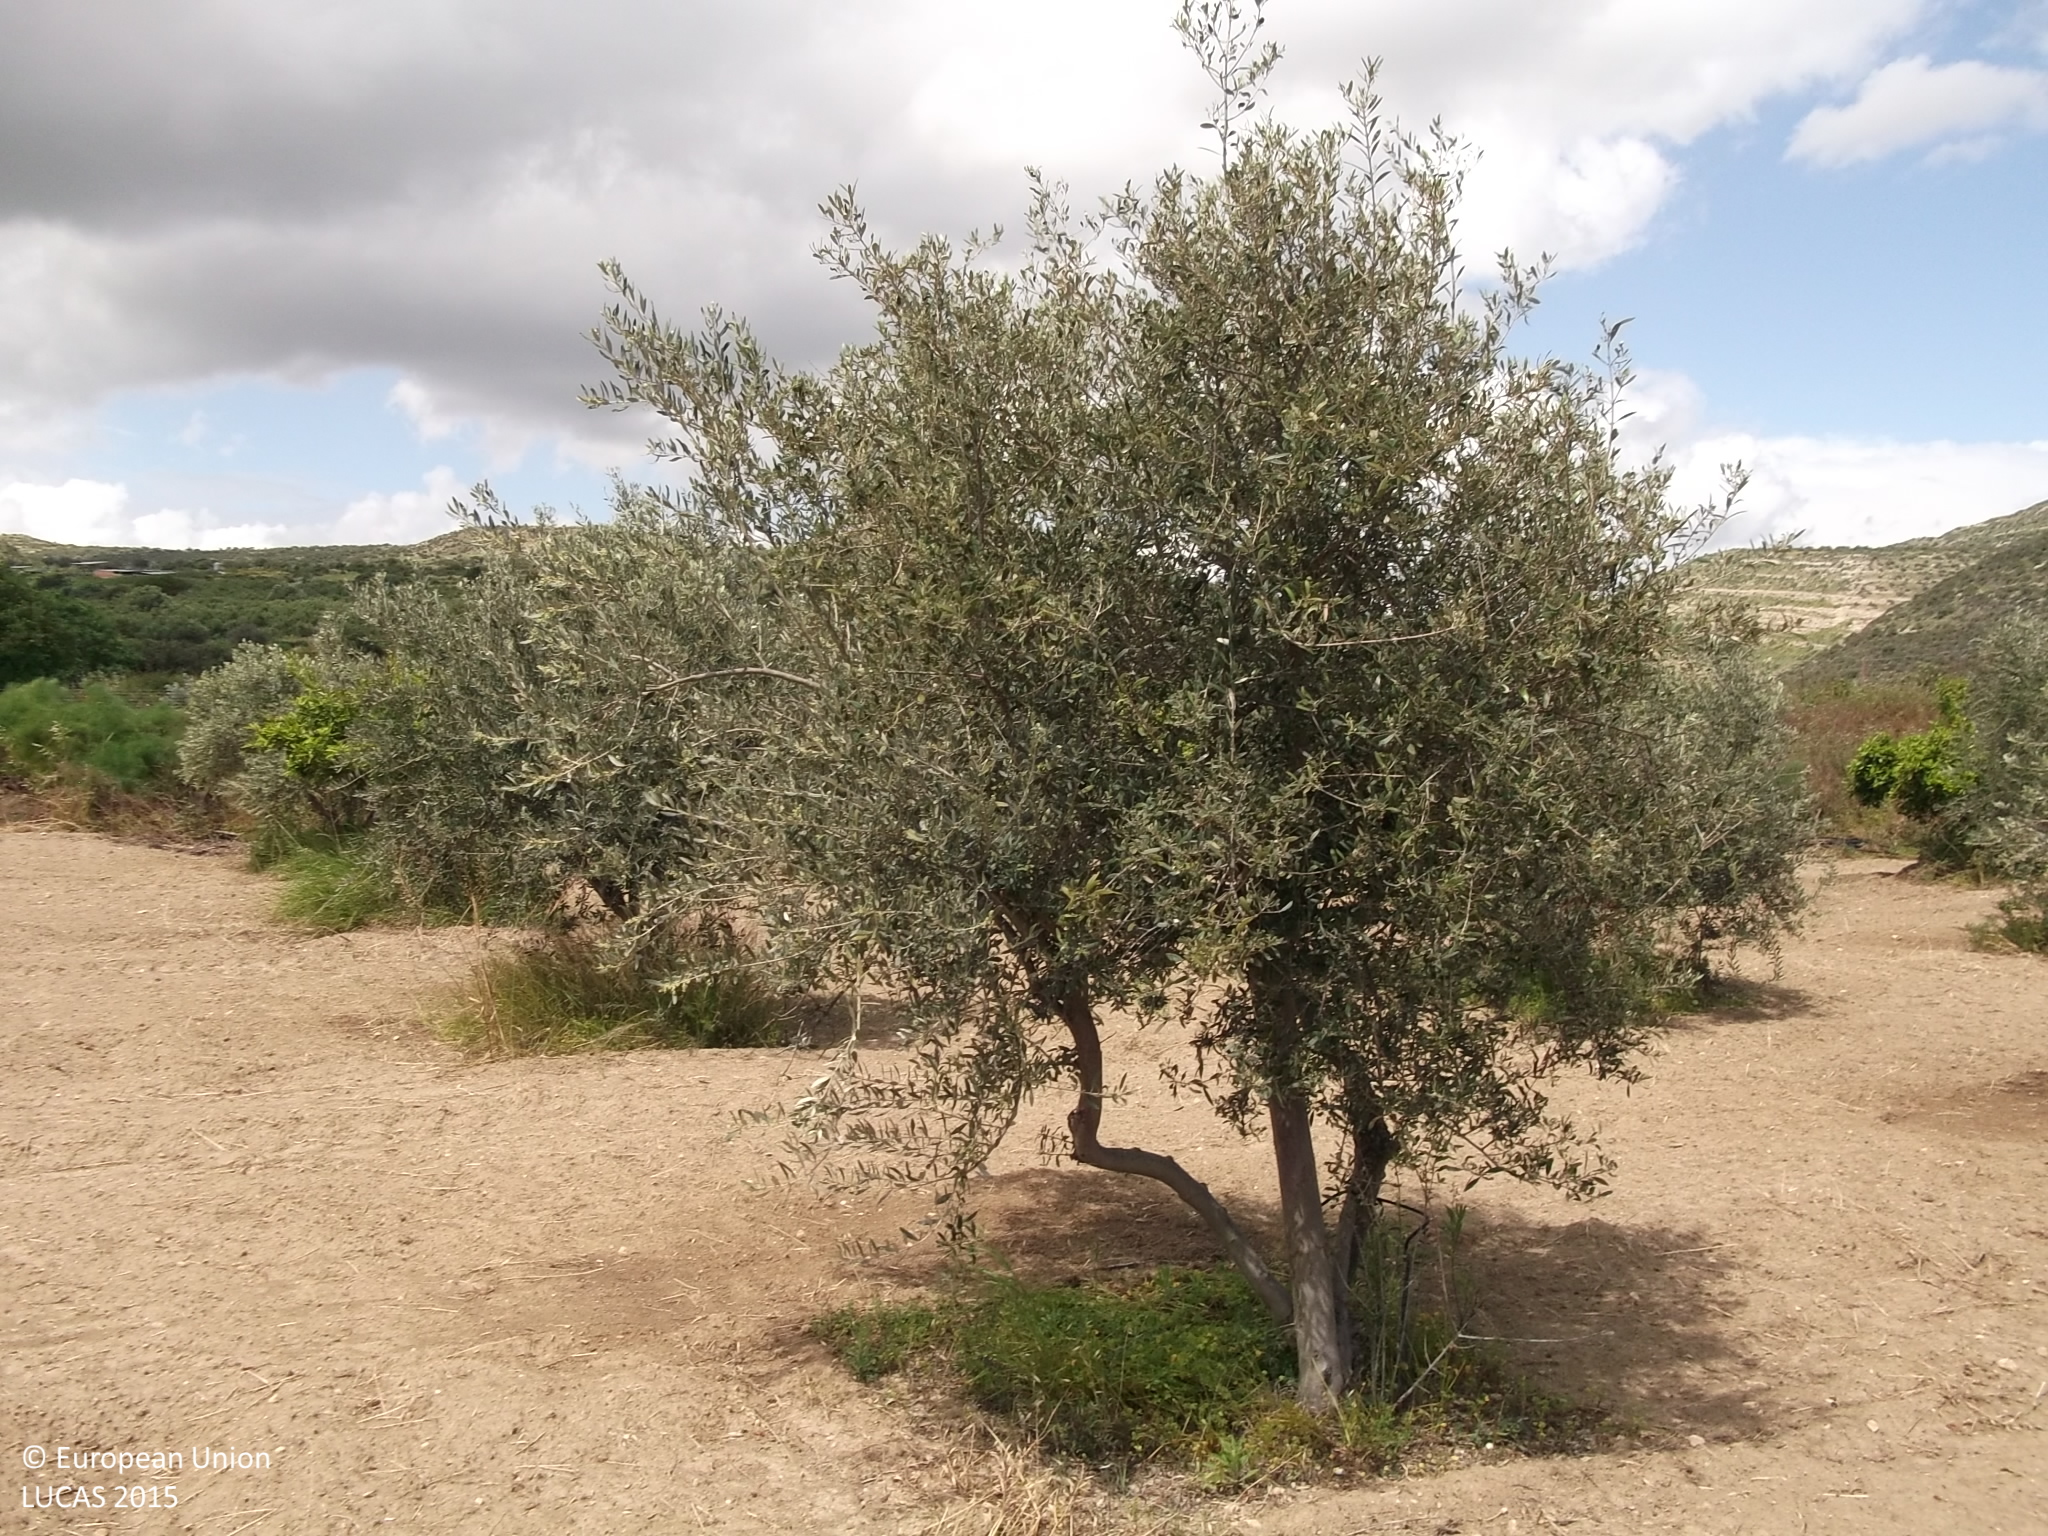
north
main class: Cropland
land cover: Olive groves
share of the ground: 25 - 50 %
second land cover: Other bare soil
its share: > 75 %
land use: Agriculture (excluding fallow land and kitchen gardens)
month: April
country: CY
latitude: 34.7660
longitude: 33.3990
